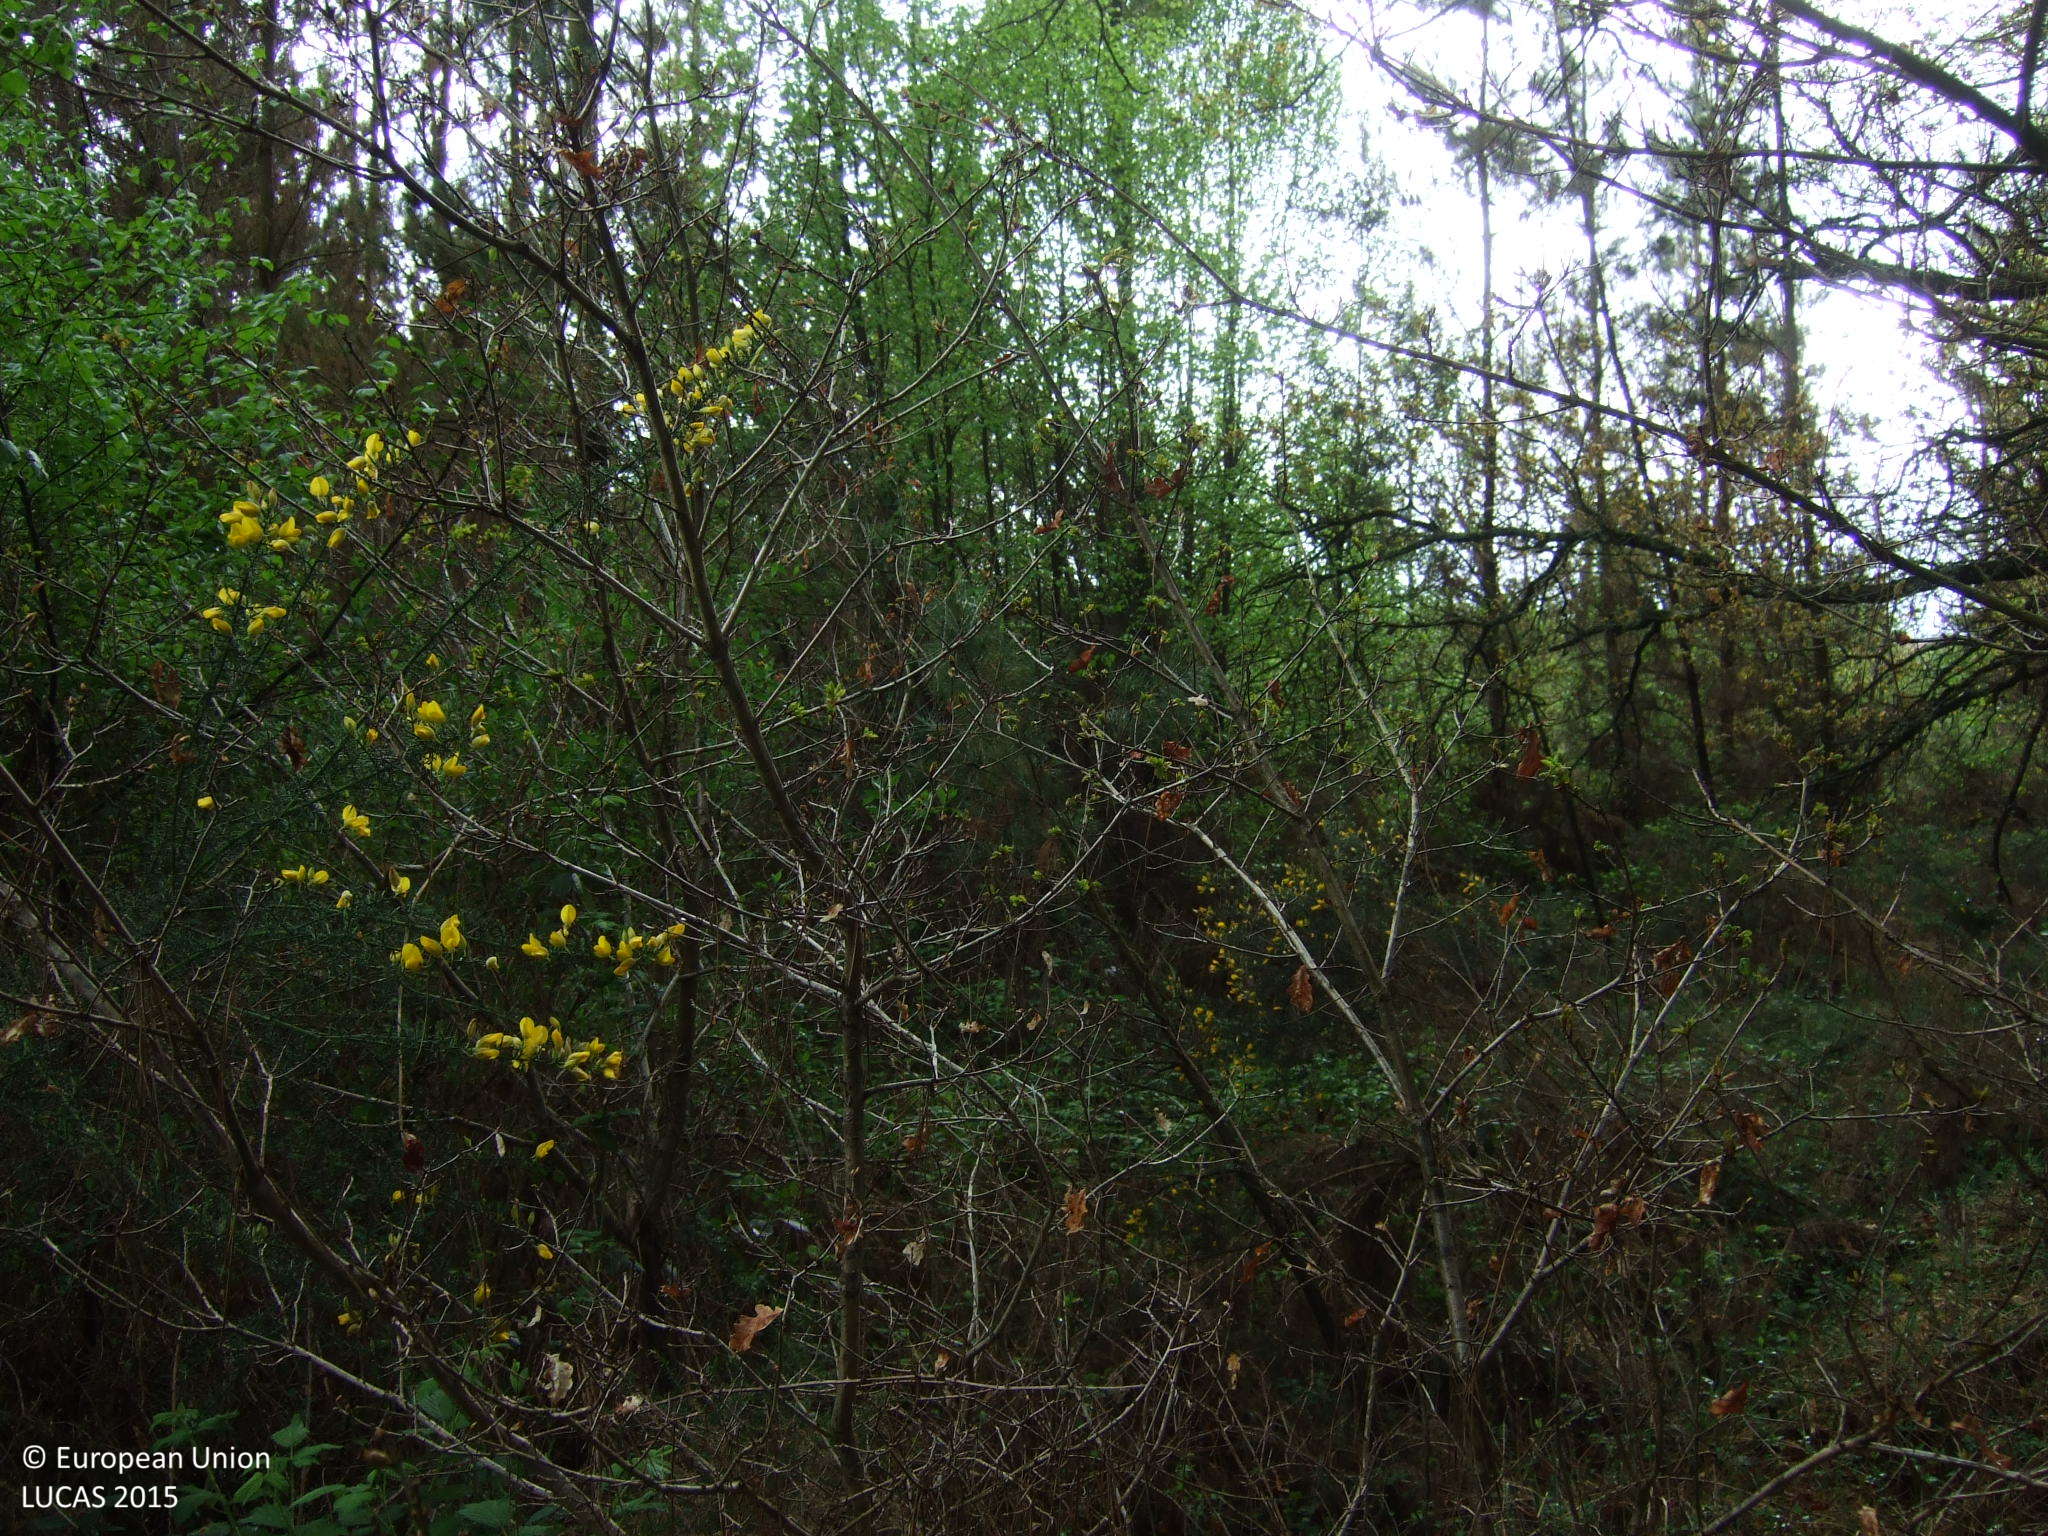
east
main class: Woodland
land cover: Pine dominated coniferous woodland
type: exotic forest
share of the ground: 25 - 50 %
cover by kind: coniferous forest trees 50 %, shrubs 50 %
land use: Forestry
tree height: > 5 m
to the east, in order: Pine dominated coniferous woodland; Groves; Grass margins; Tracks; Electric lines; Broadleaved woodland; Pine dominated coniferous woodland; Broadleaved woodland
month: April
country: ES
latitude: 42.9381
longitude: -7.4124
